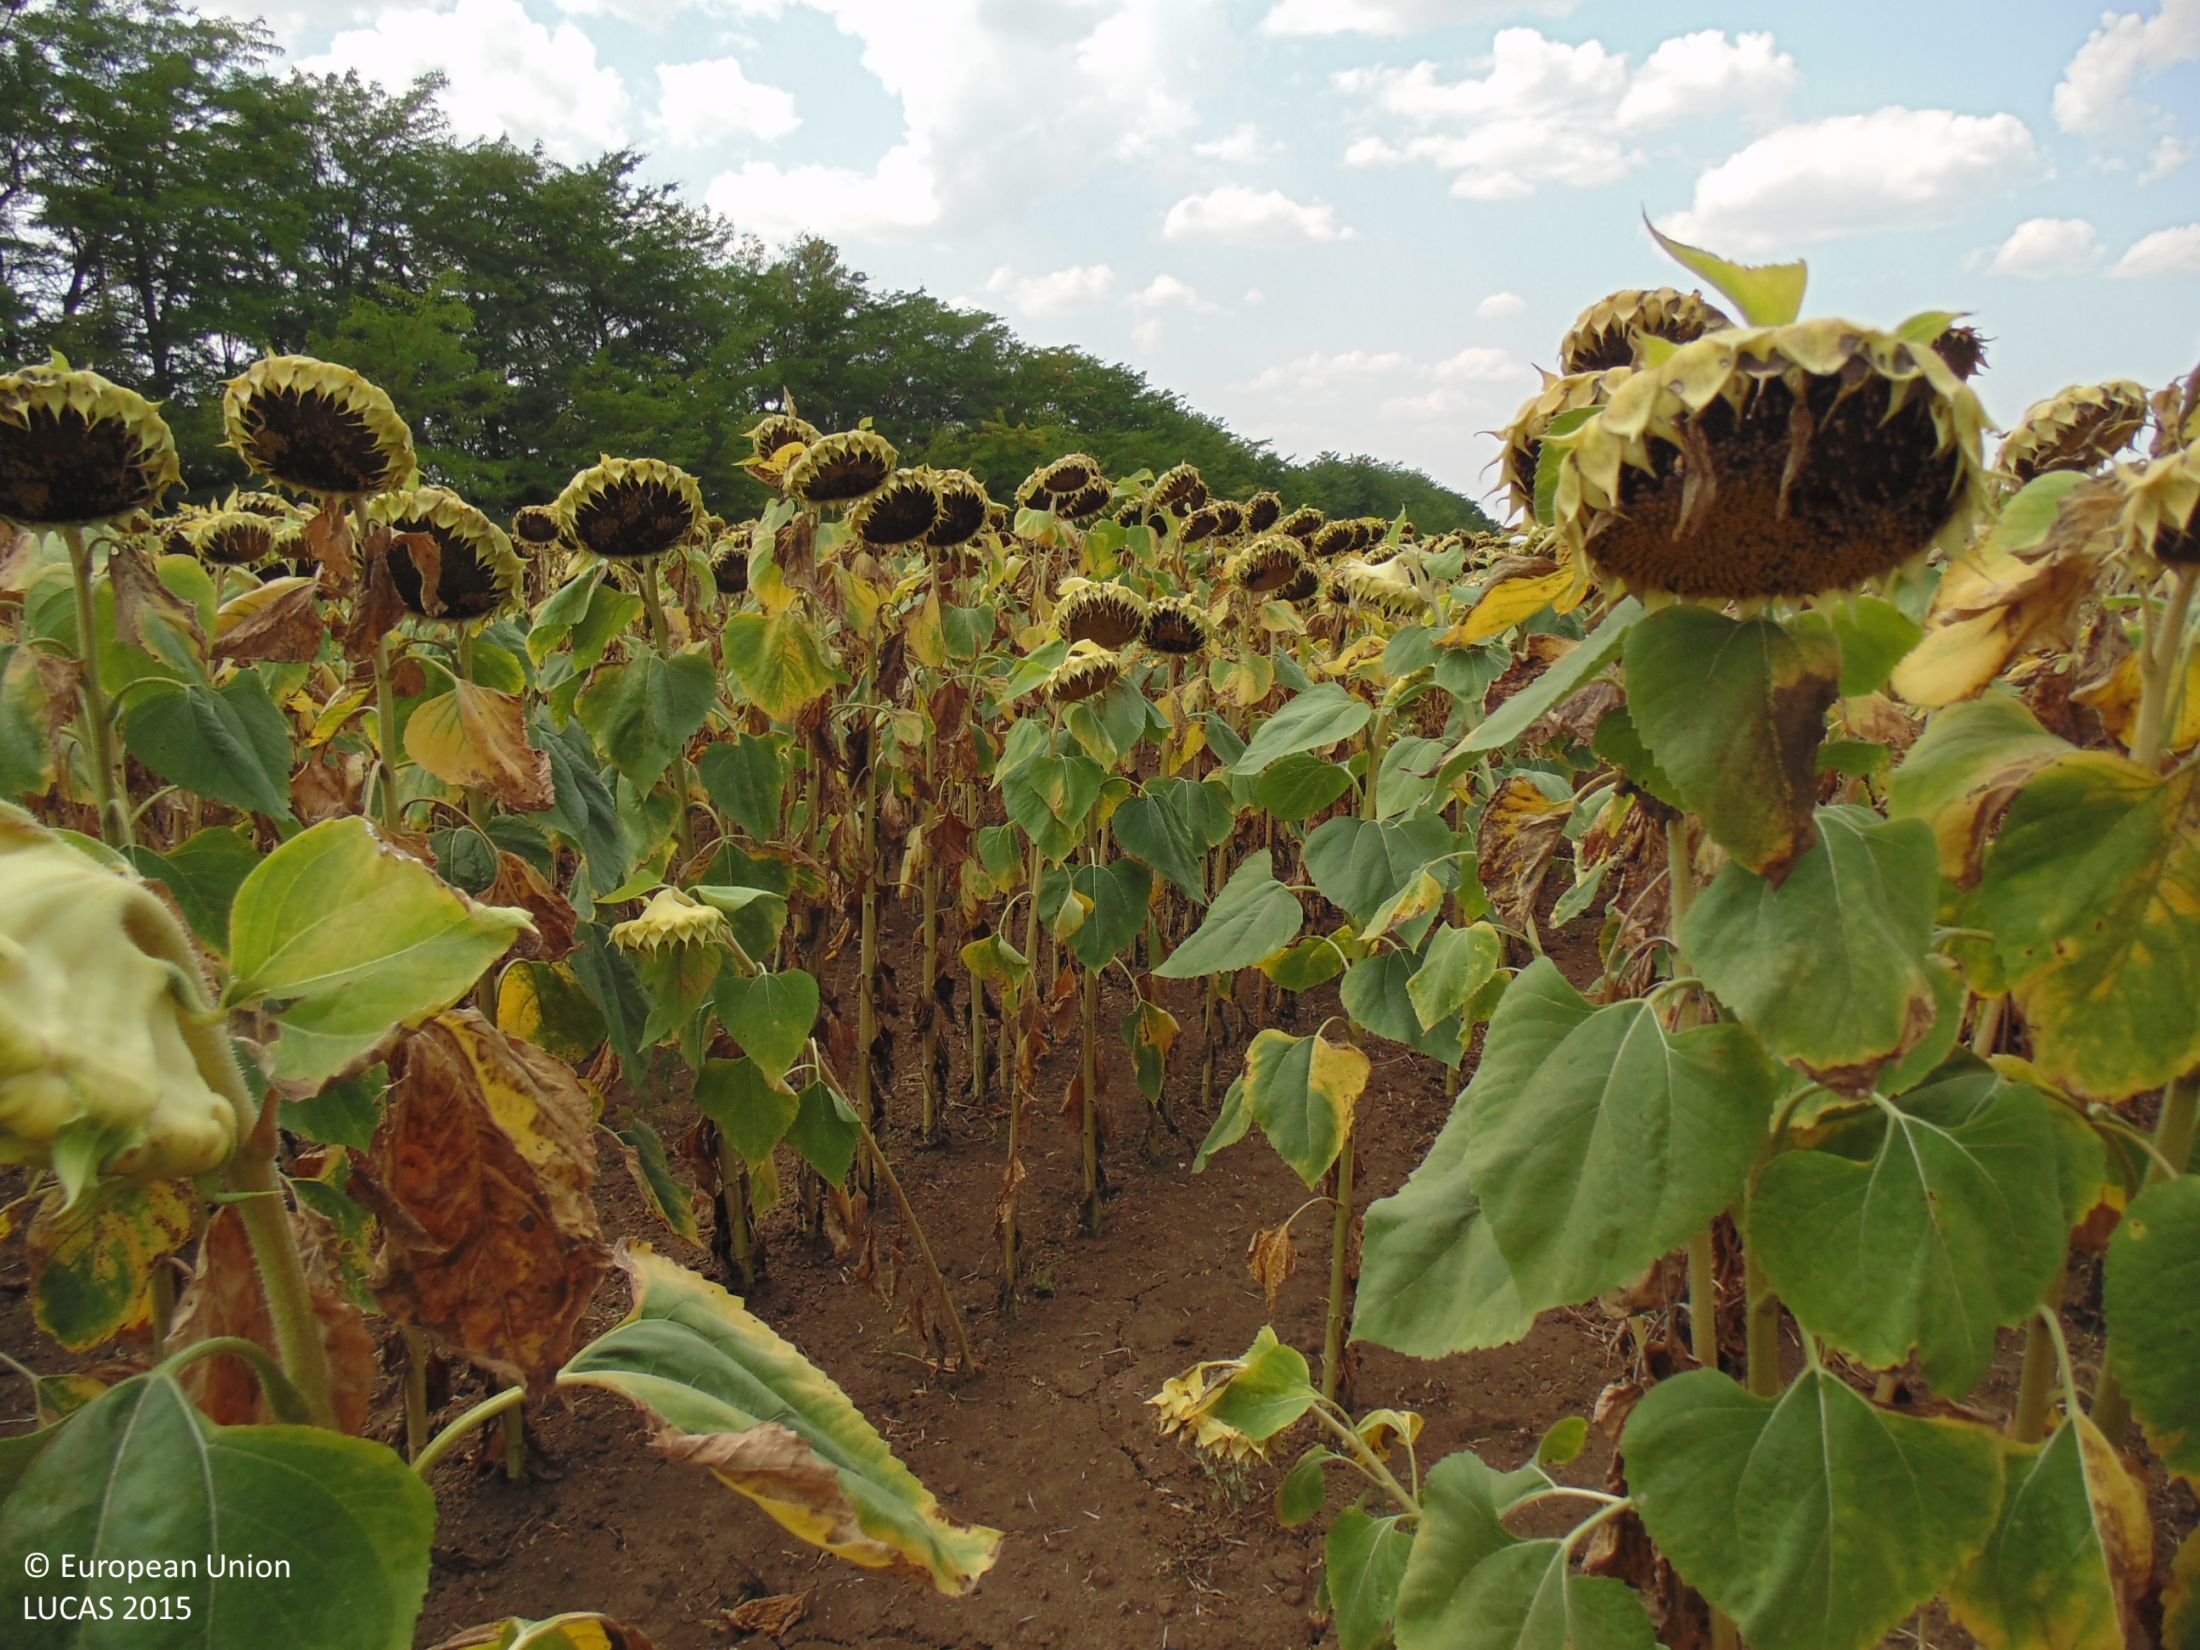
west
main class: Cropland
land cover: Sunflower
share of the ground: > 75 %
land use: Agriculture (excluding fallow land and kitchen gardens)
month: August
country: BG
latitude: 43.8596
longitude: 27.5168
